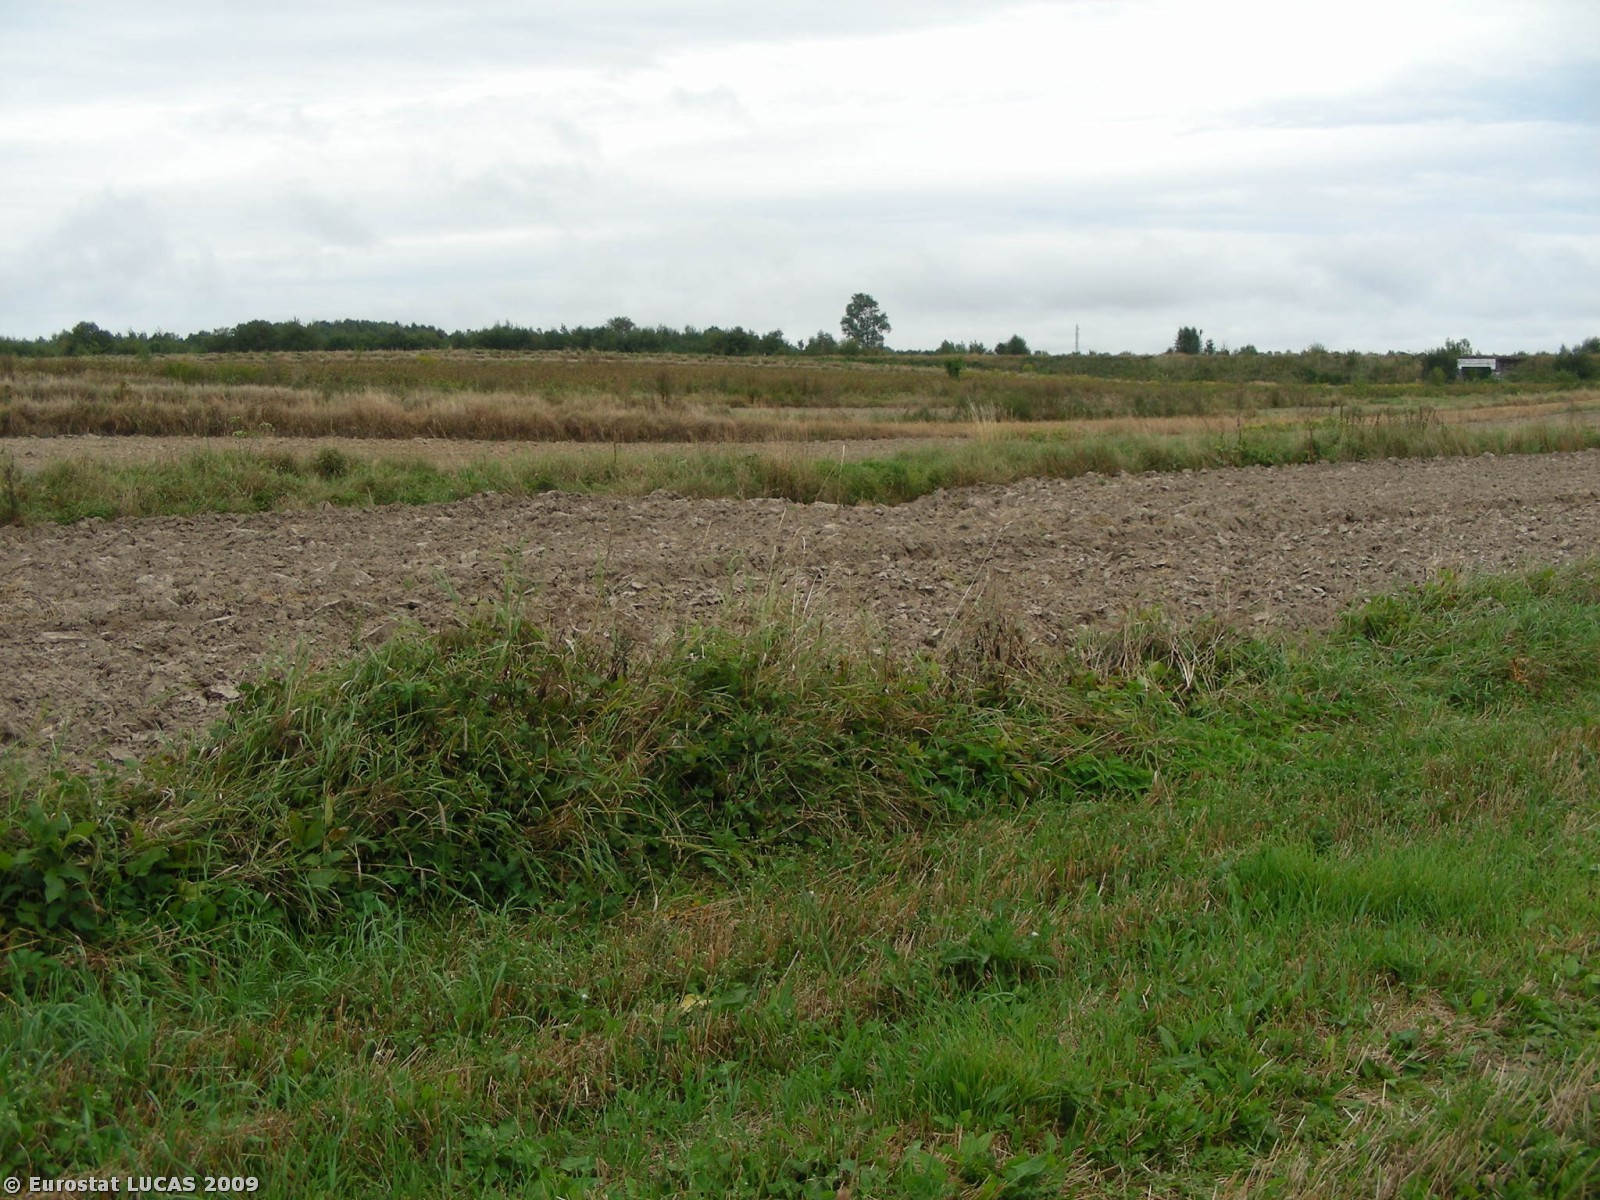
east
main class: Cropland
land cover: Common wheat
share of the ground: < 10 %
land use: Agriculture (excluding fallow land and kitchen gardens)
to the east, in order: Common wheat; Grass margins; Triticale; Grass margins; Common wheat; Mixed cereals for fodder; Grass margins; Common wheat; Grass margins; Other fruit trees and berries; Grassland with sparse tree/shrub cover; Grass margins; Mixed cereals for fodder; Tracks; Triticale; Common wheat
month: September
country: PL
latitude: 50.8413
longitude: 22.3188
